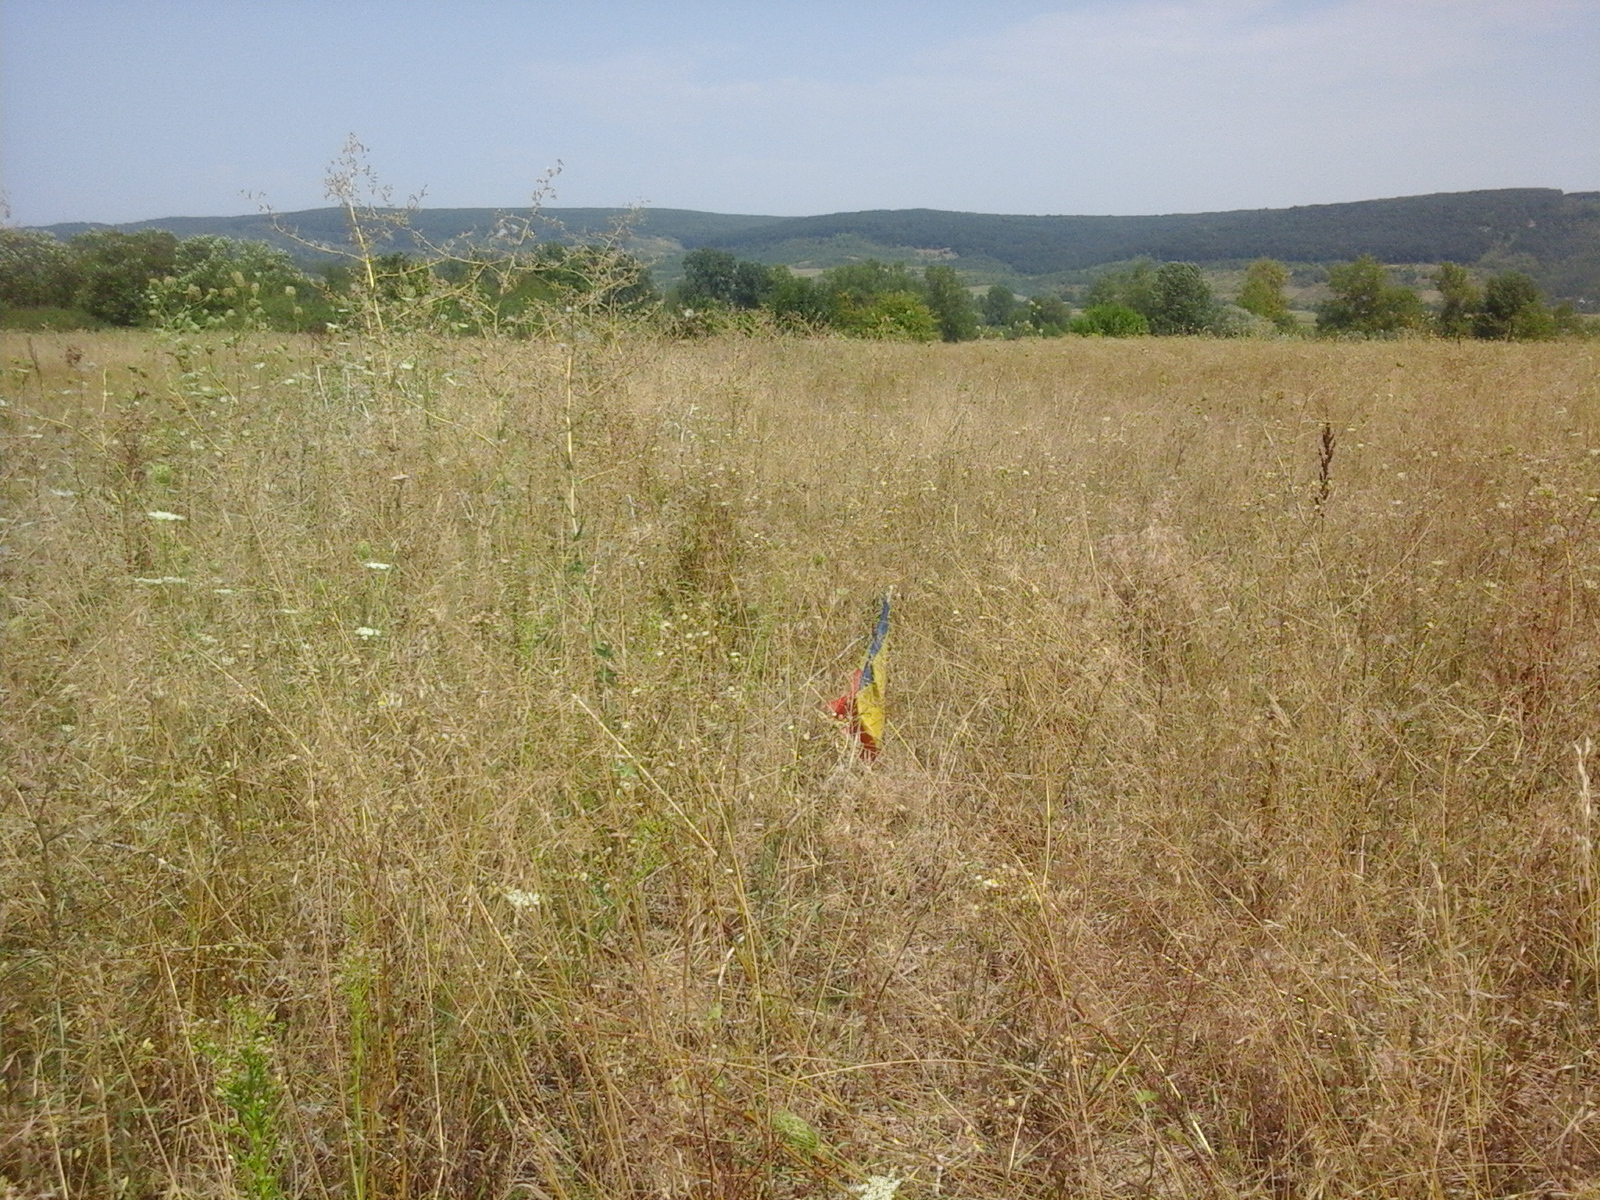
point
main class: Grassland
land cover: Spontaneously vegetated surfaces
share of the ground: > 75 %
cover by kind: herbaceous plants 100 %
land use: Agriculture (excluding fallow land and kitchen gardens)
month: August
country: RO
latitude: 44.5838
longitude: 23.3136
